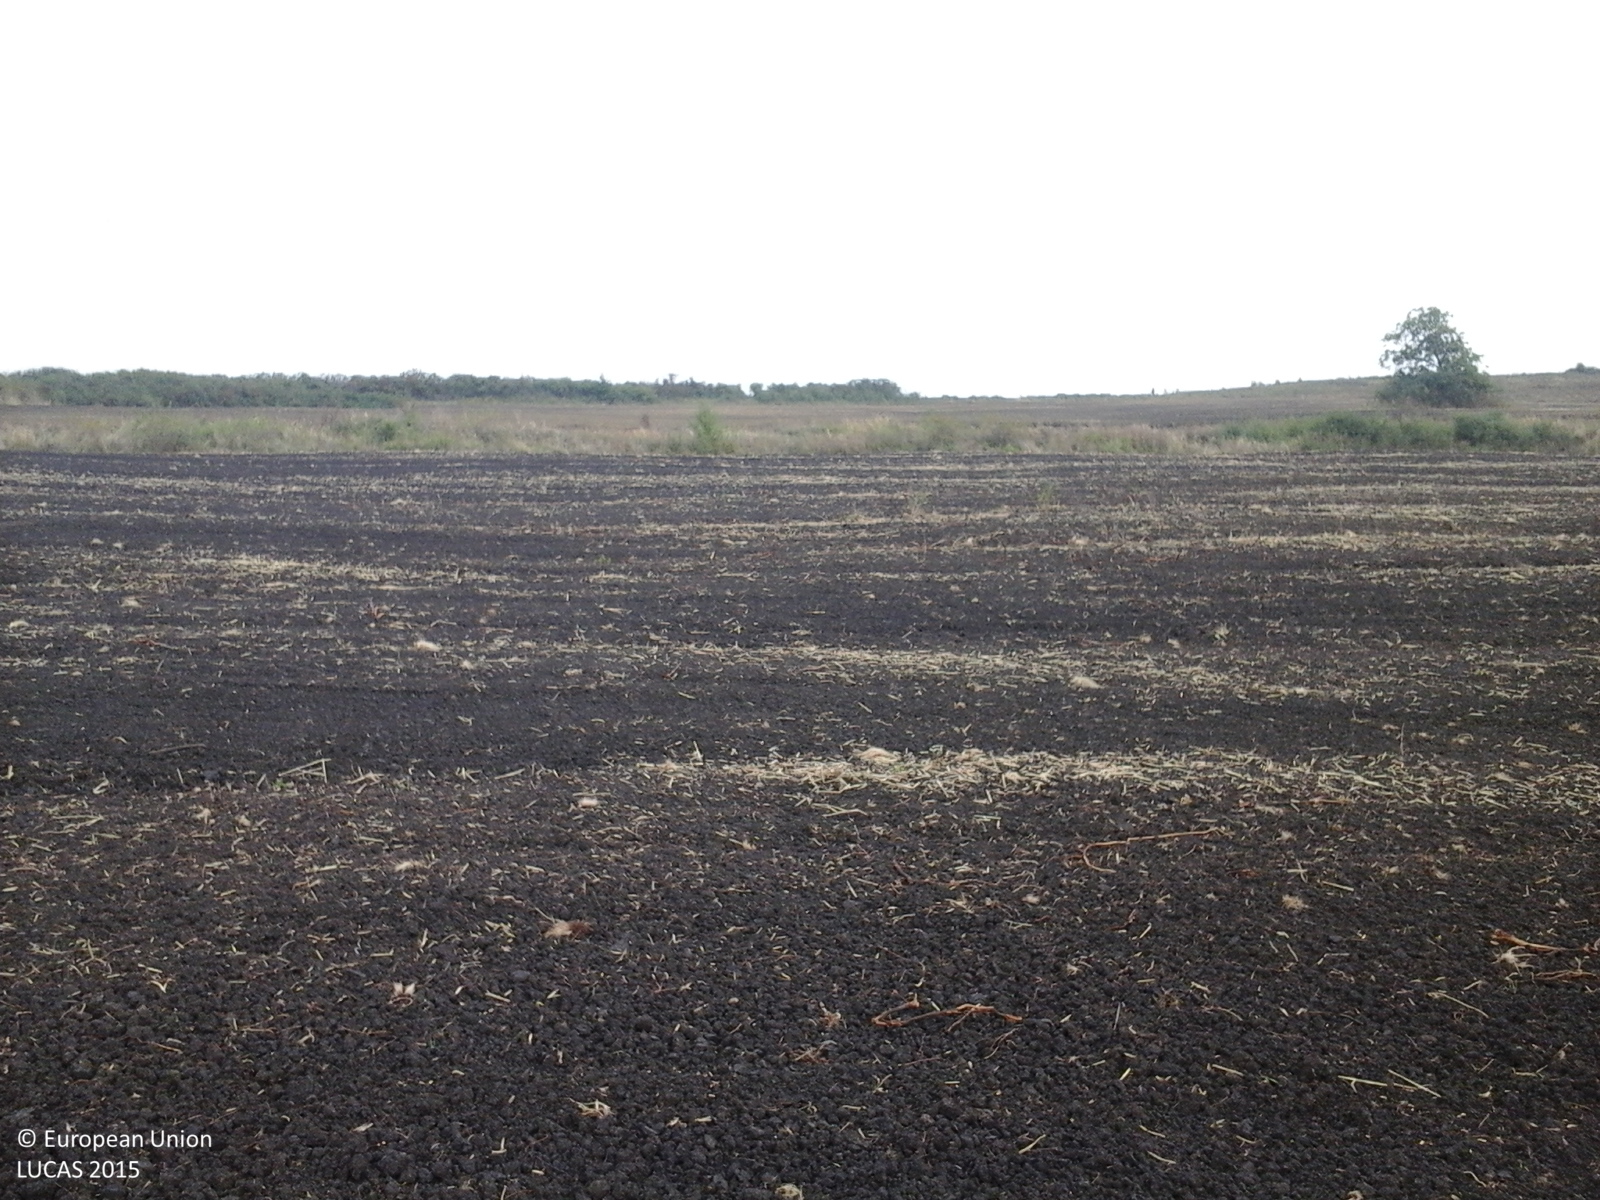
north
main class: Cropland
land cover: Common wheat
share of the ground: < 10 %
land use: Agriculture (excluding fallow land and kitchen gardens)
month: September
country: RO
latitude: 47.2785
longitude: 23.0599
